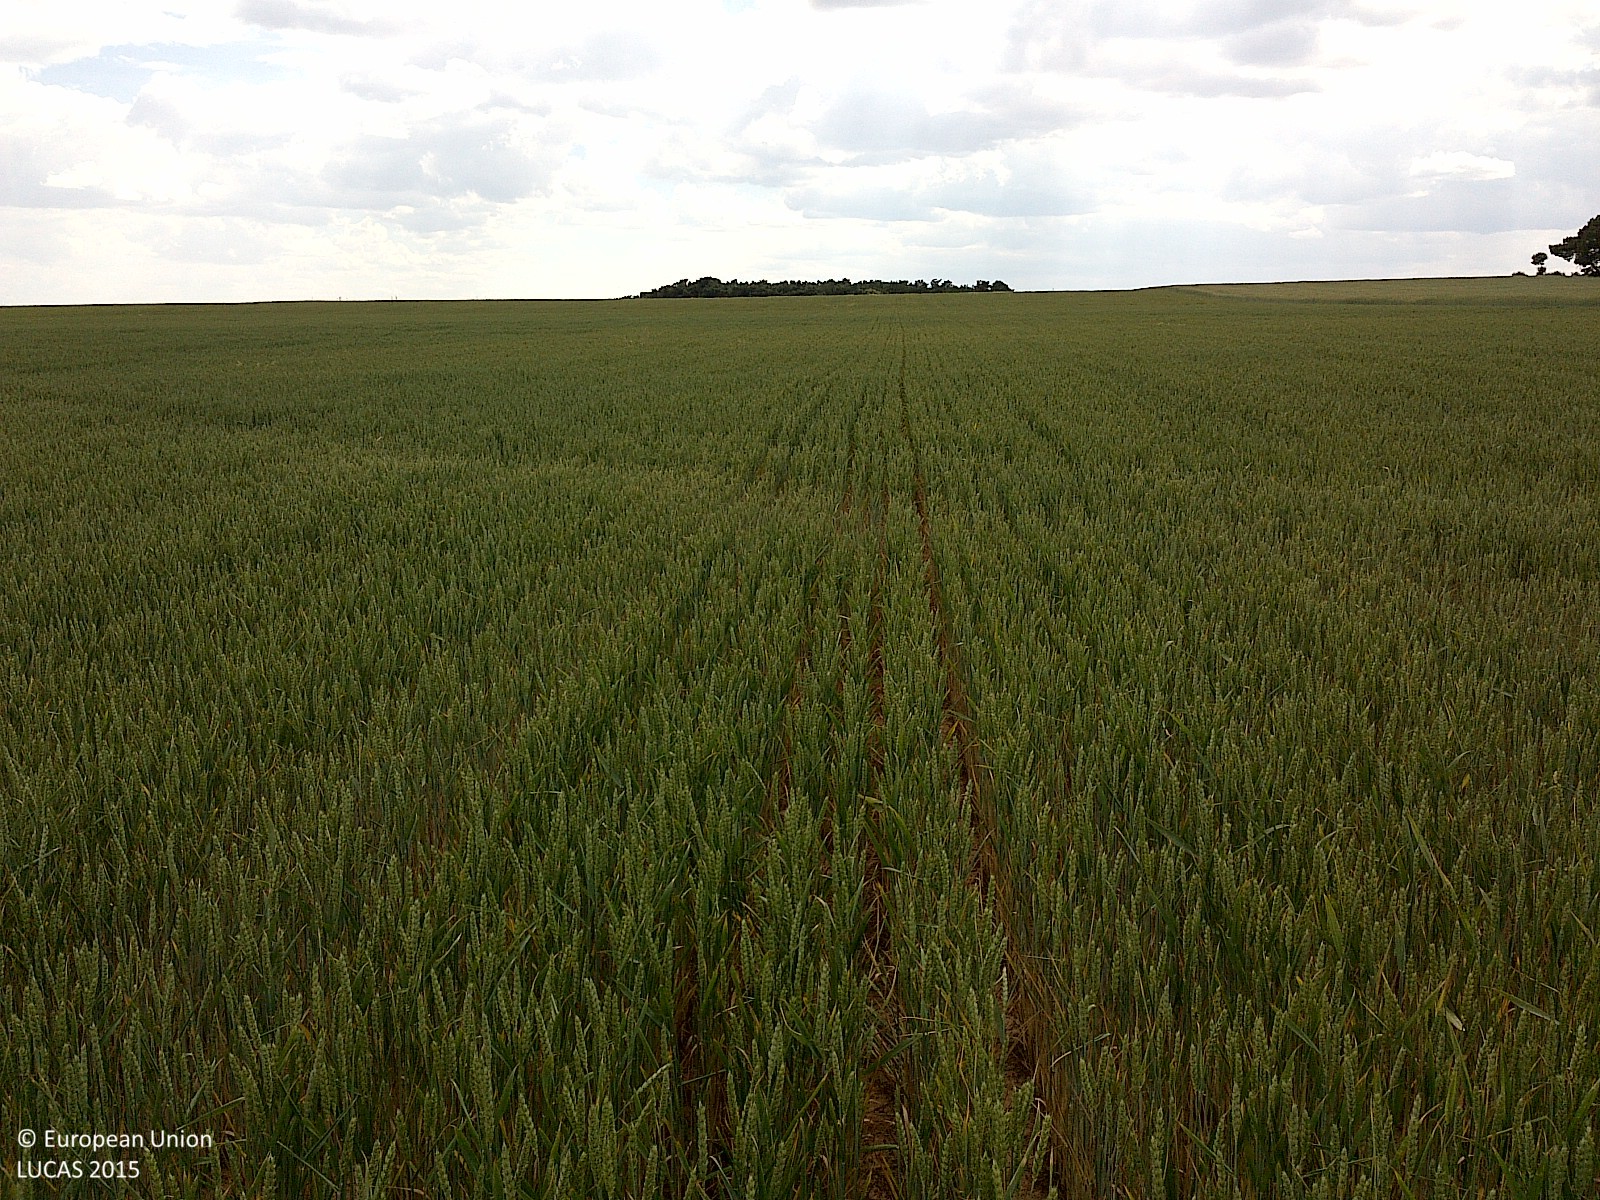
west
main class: Cropland
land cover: Common wheat
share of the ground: > 75 %
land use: Agriculture (excluding fallow land and kitchen gardens)
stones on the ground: < 10 %
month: June
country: ES
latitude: 41.7324
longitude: -2.1894
